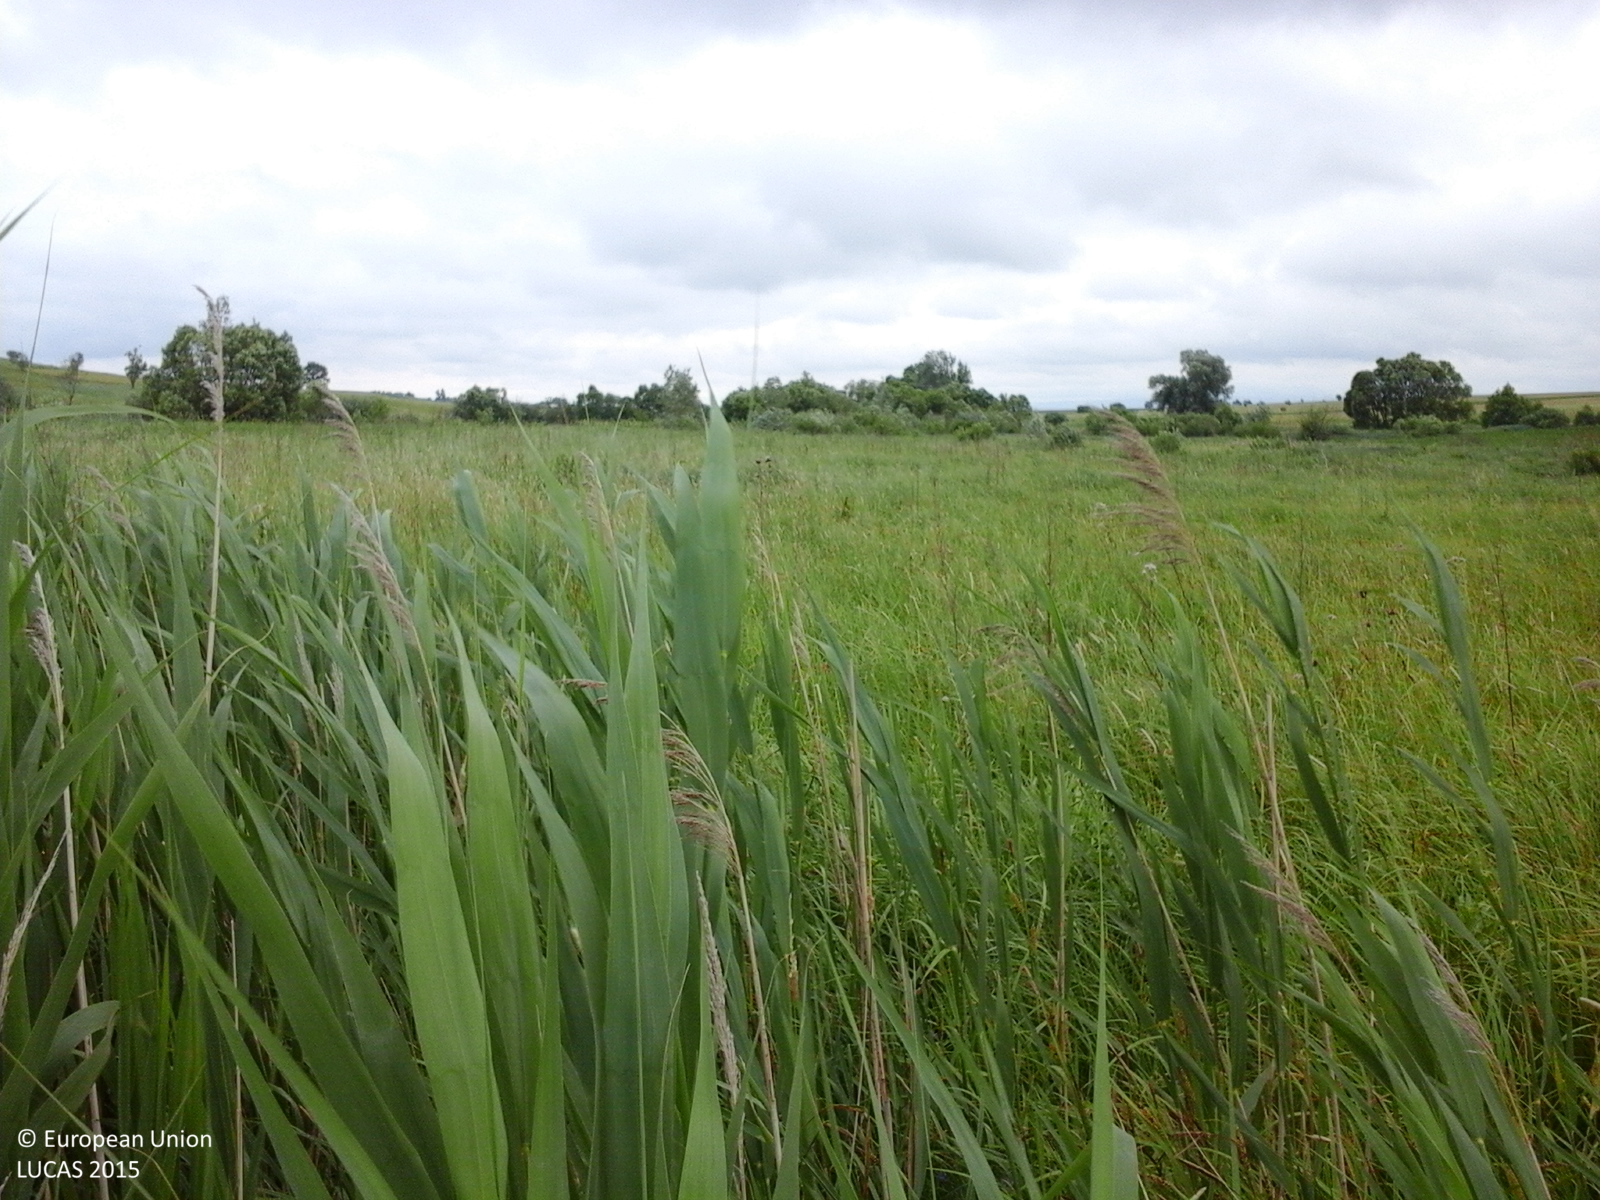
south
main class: Grassland
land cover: Spontaneously vegetated surfaces
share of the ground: > 75 %
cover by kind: herbaceous plants 100 %
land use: Fallow land
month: June
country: RO
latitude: 47.9634
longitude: 25.8654
